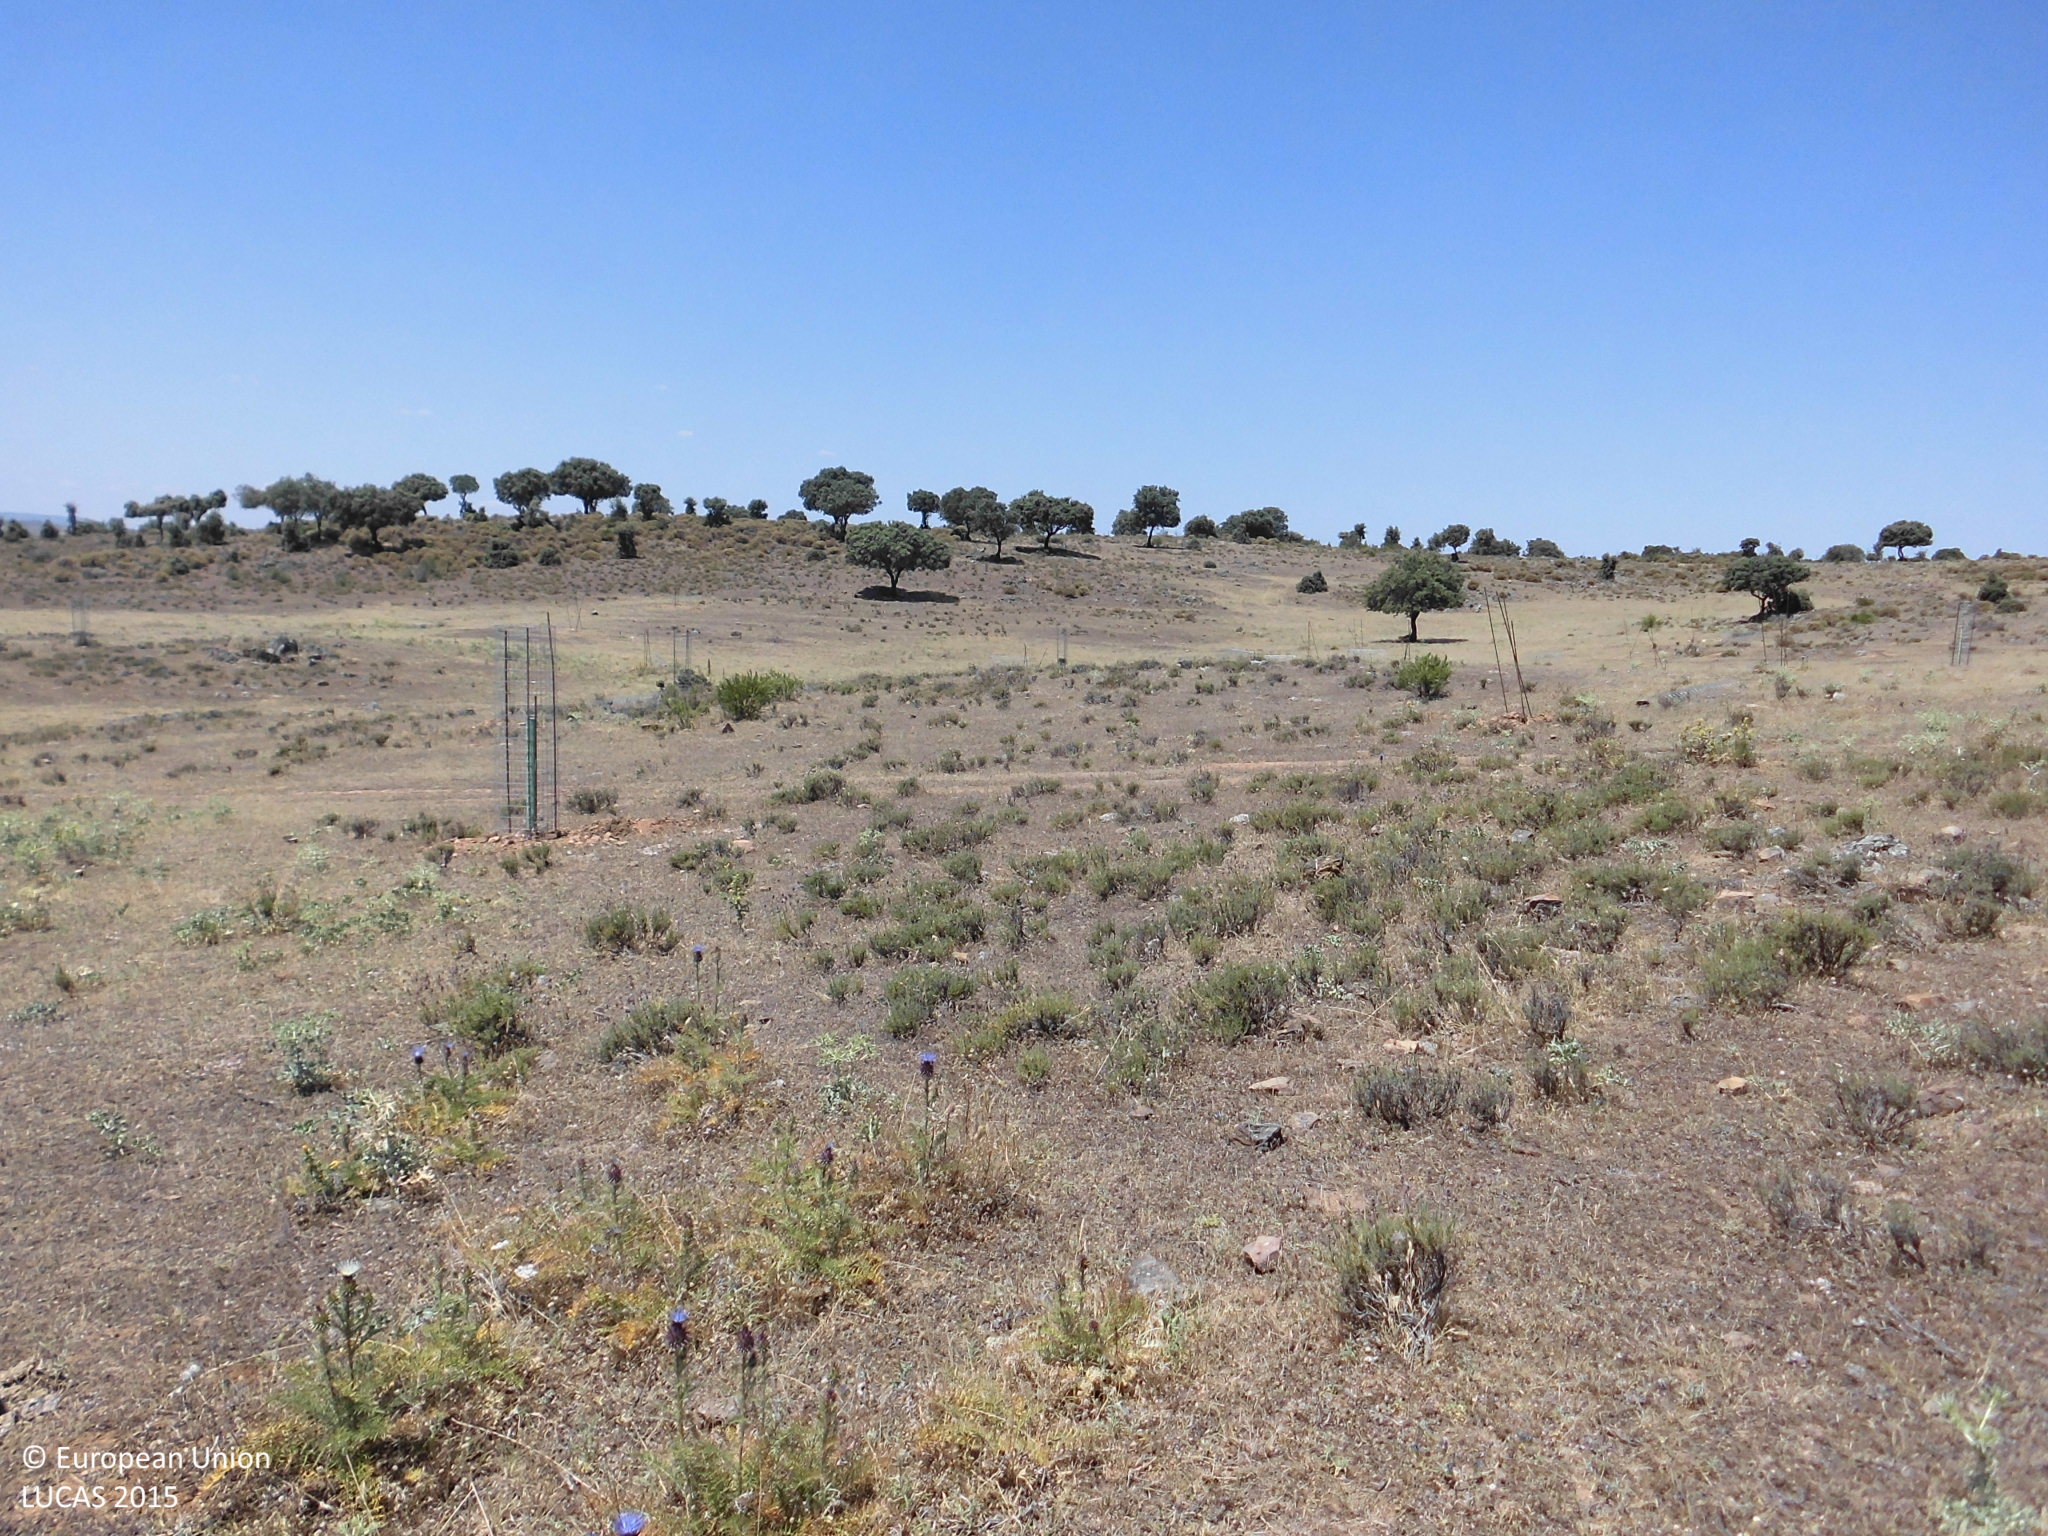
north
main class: Shrubland
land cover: Shrubland with sparse tree cover
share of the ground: 10 - 25 %
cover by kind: herbaceous plants 75 %, shrubs 20 %, broadleaved forest trees 5 %
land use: Agriculture (excluding fallow land and kitchen gardens)
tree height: > 5 m
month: May
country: ES
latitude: 39.8461
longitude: -6.7599
